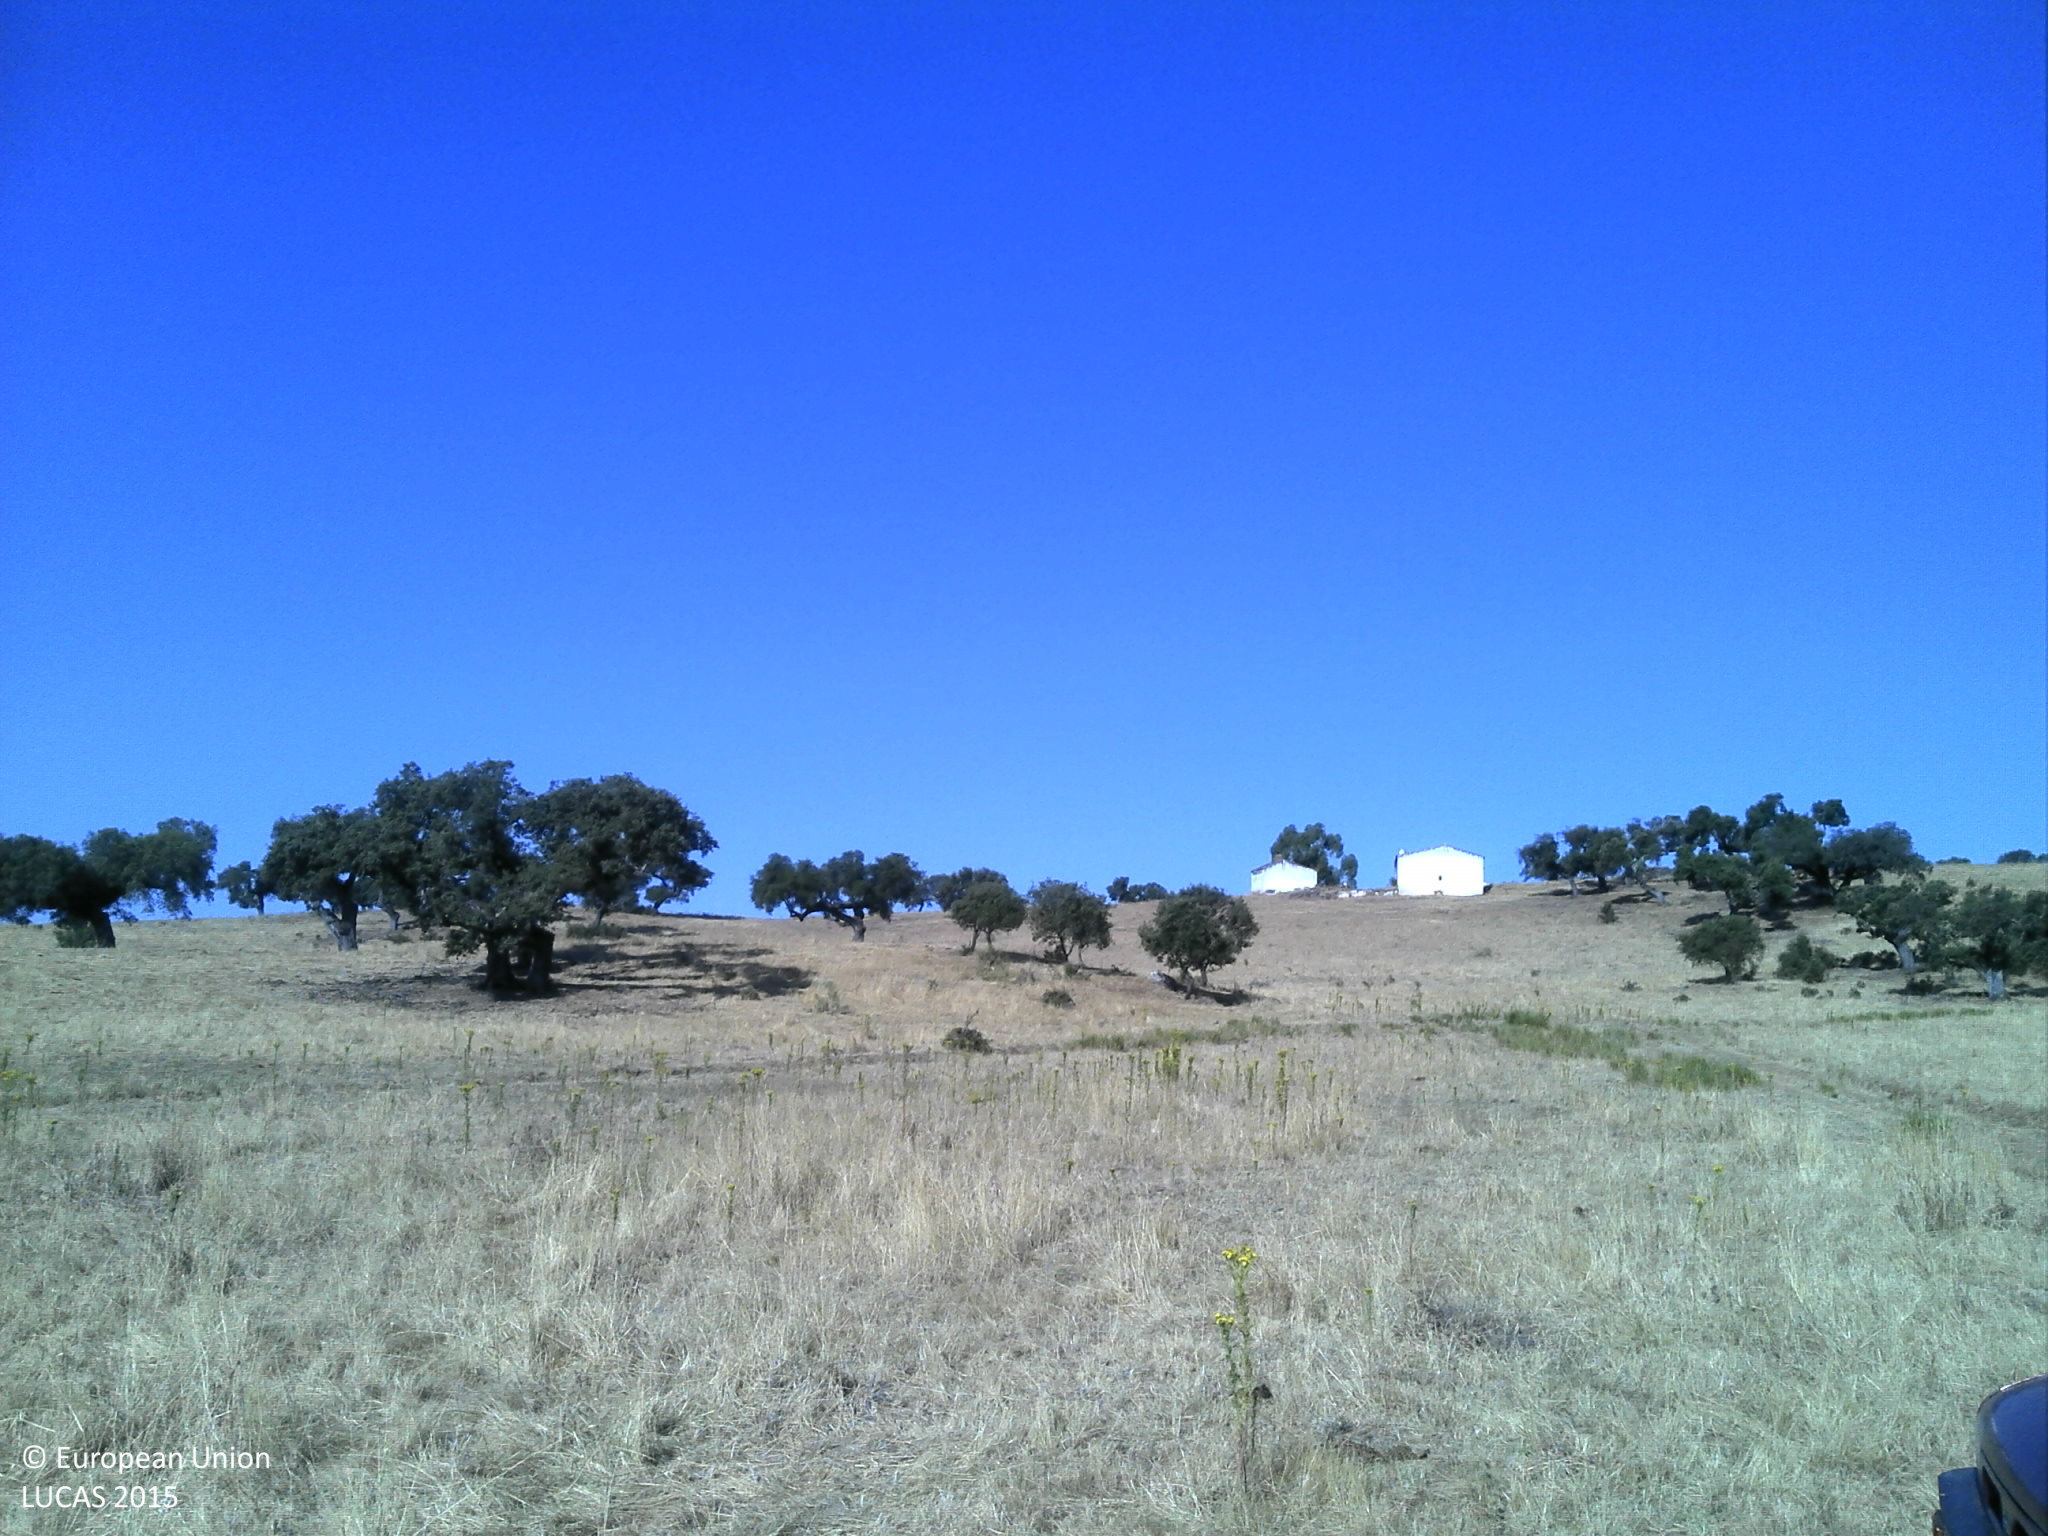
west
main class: Grassland
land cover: Grassland without tree/shrub cover
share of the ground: 50 - 75 %
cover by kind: herbaceous plants 60 %, unconsolidated bare surface 40 %
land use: Agriculture (excluding fallow land and kitchen gardens)
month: July
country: PT
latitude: 38.6619
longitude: -7.2998
